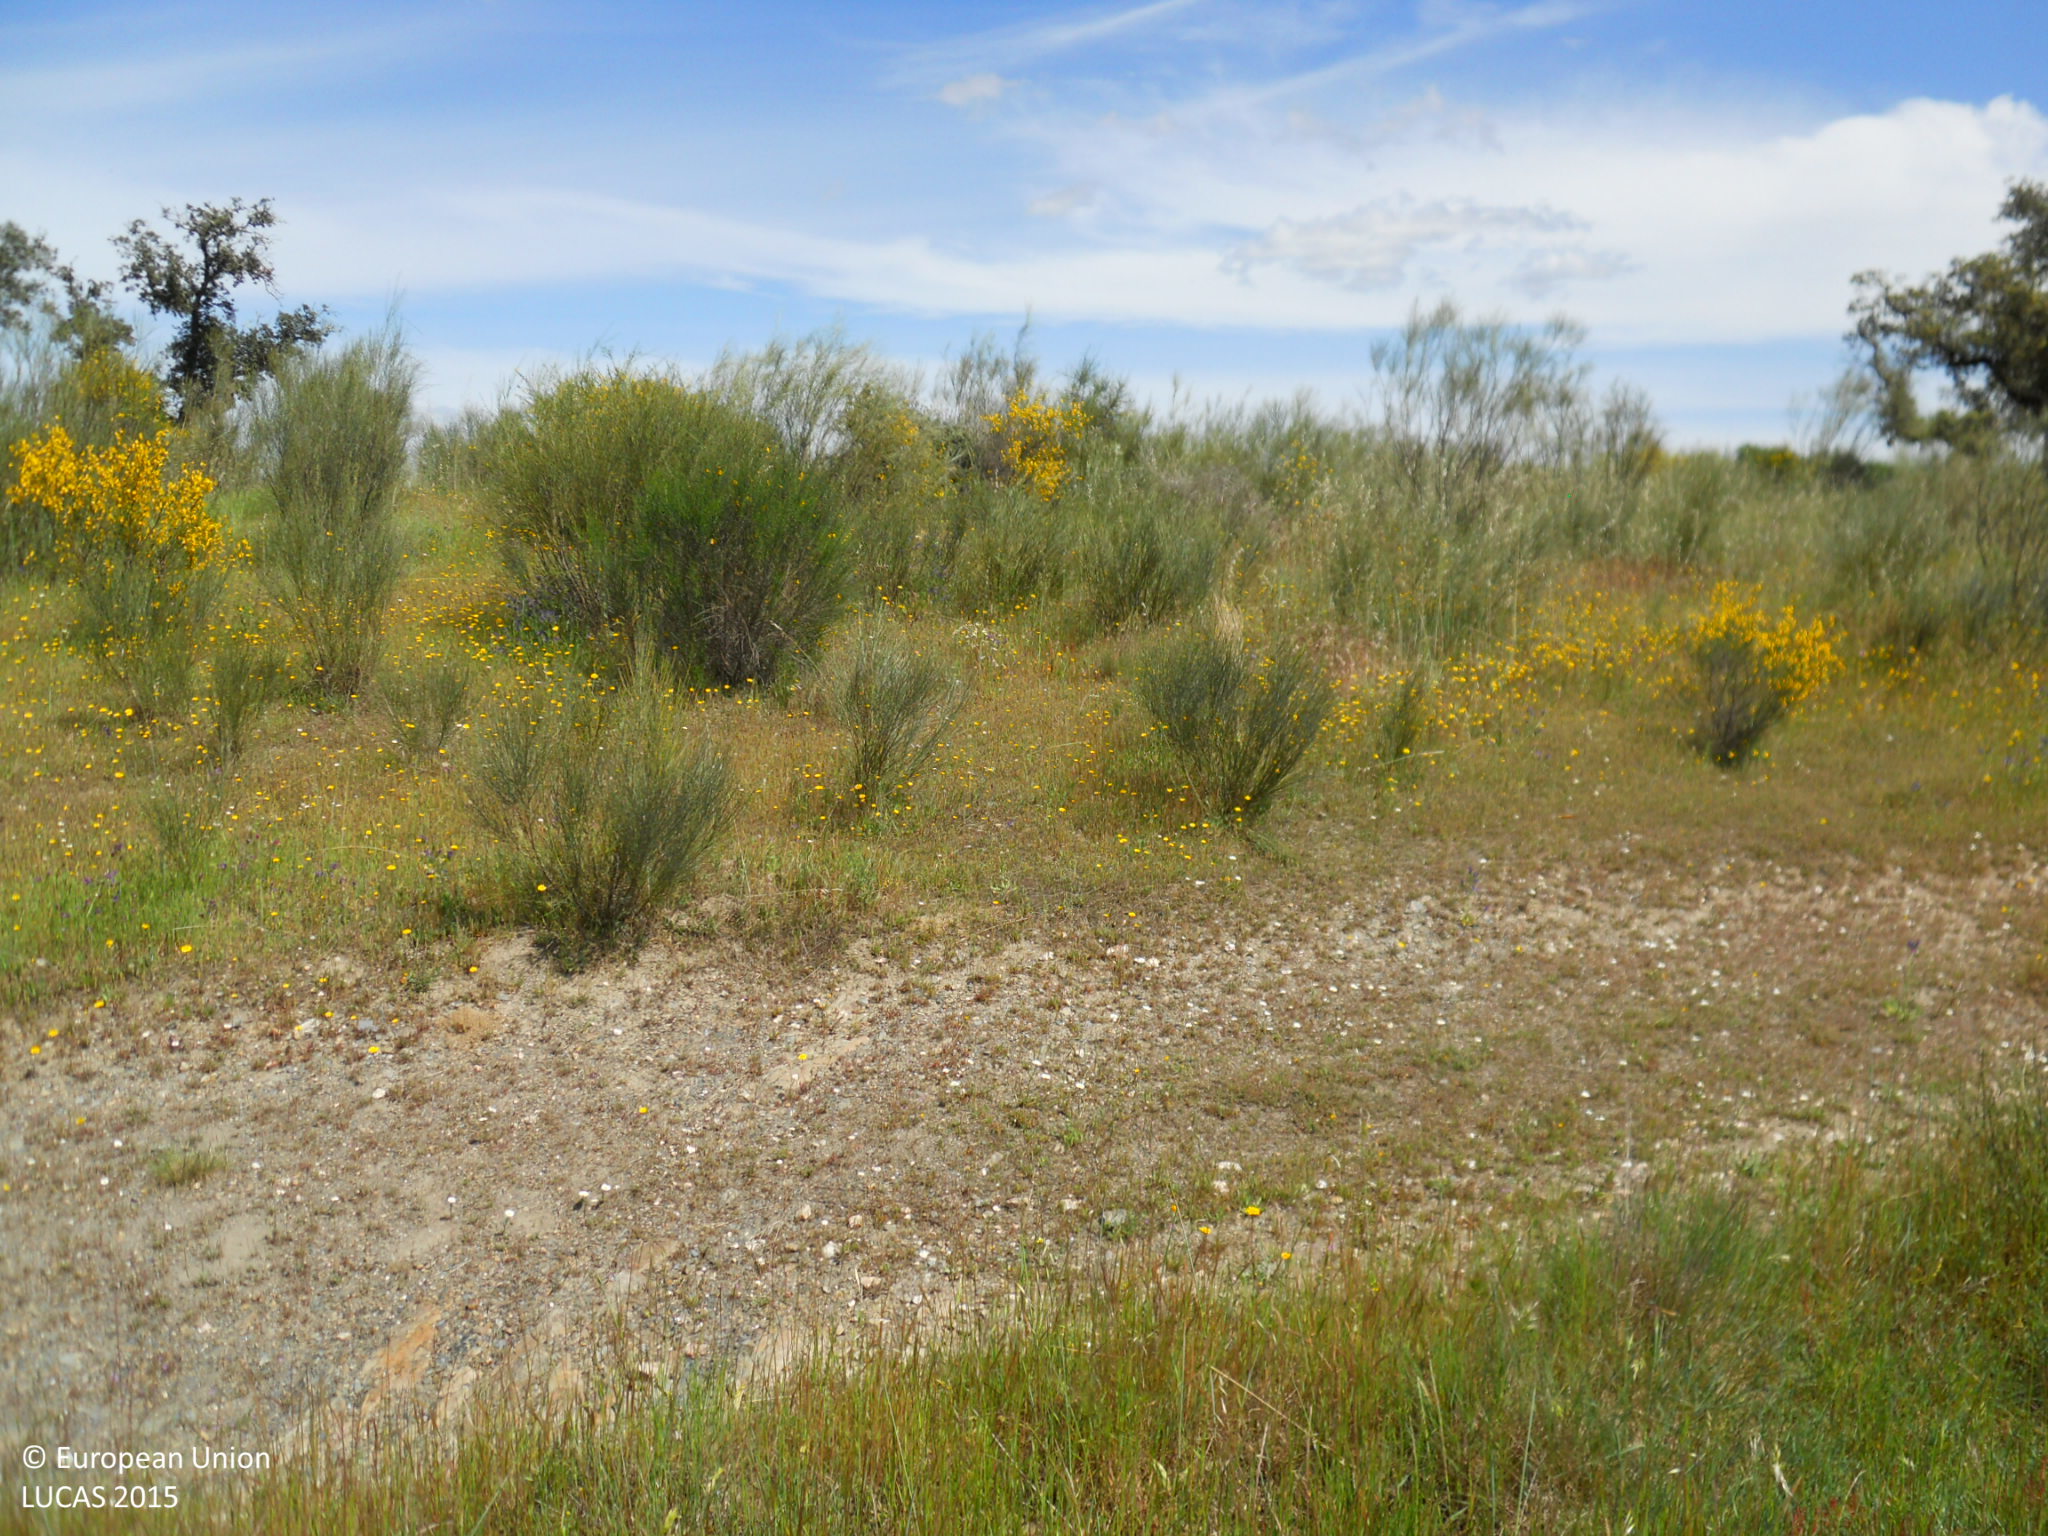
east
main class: Grassland
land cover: Grassland without tree/shrub cover
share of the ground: > 75 %
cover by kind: herbaceous plants 95 %, shrubs 5 %
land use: Agriculture (excluding fallow land and kitchen gardens)
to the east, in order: Grassland without tree/shrub cover; Tracks; Grassland without tree/shrub cover; Other structural elements; Grassland with sparse tree/shrub cover; Fences; Grassland with sparse tree/shrub cover; Rivers and streams; Grassland with sparse tree/shrub cover; Fences; Dry stone walls; Oats
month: April
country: ES
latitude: 39.2688
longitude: -7.1066
